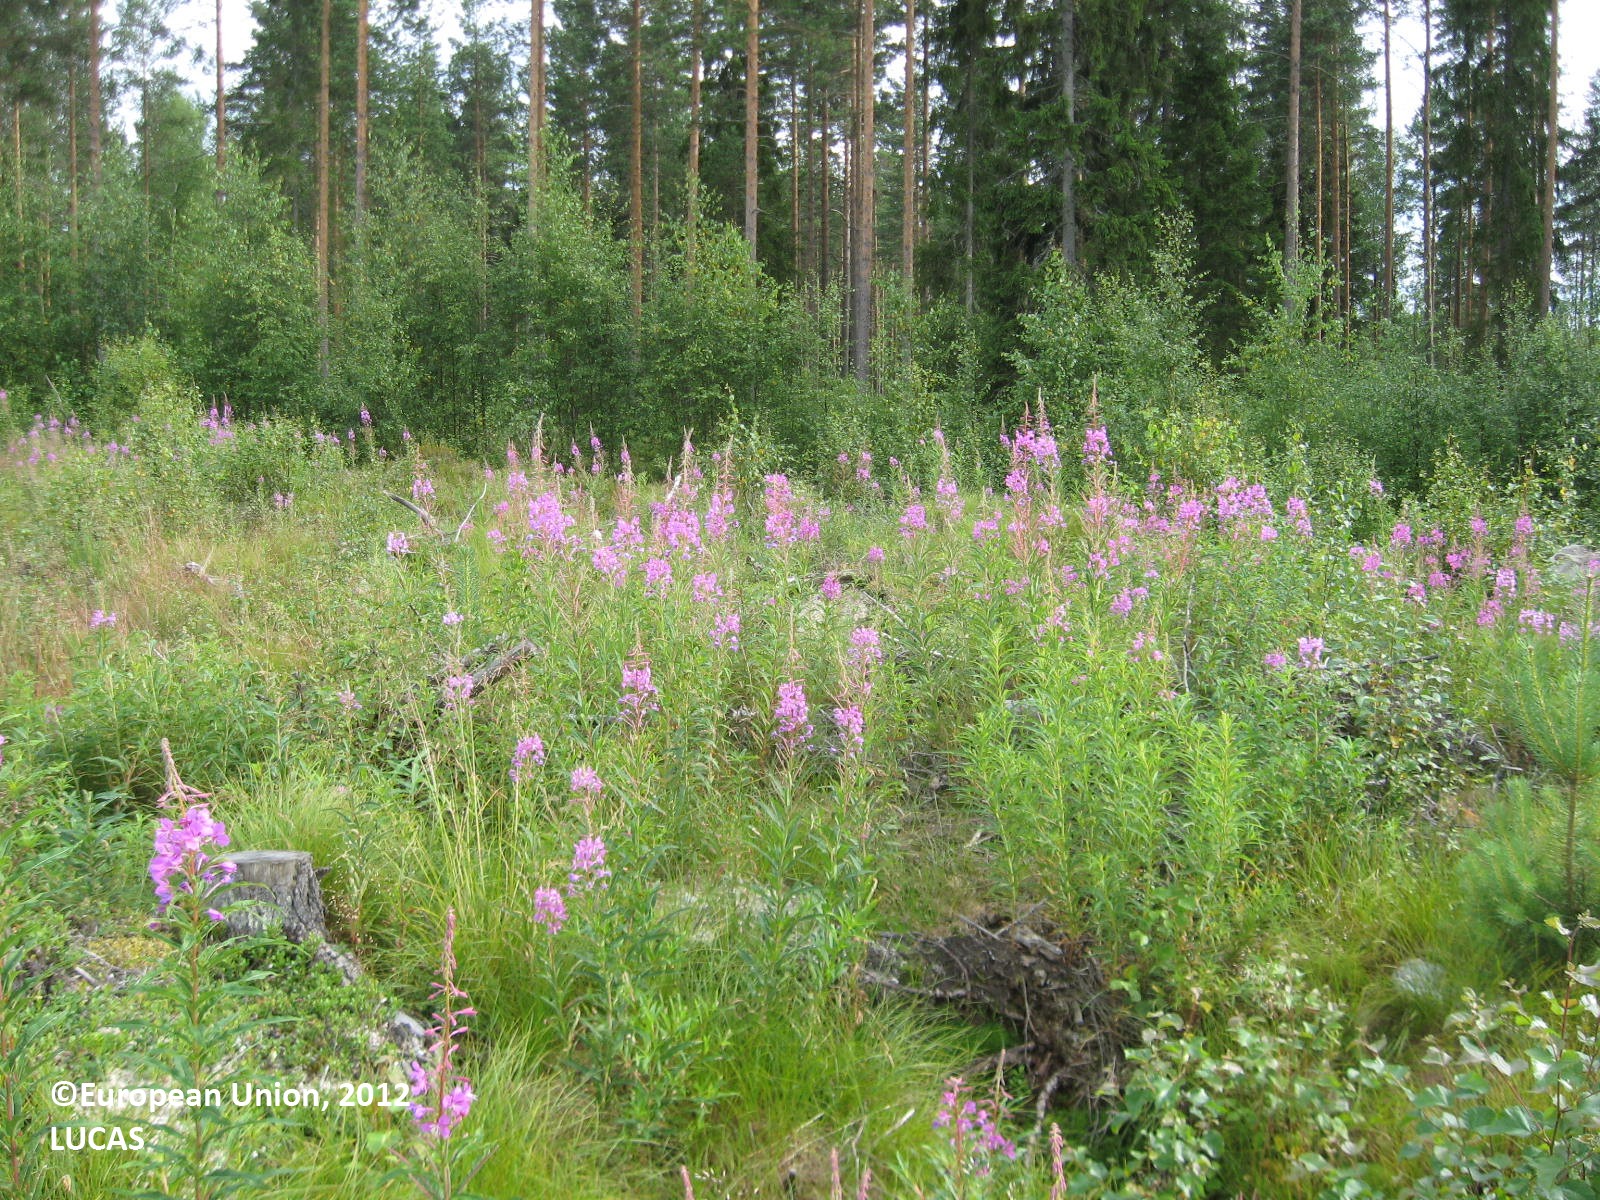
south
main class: Grassland
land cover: Grassland with sparse tree/shrub cover
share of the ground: 10 - 25 %
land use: Forestry
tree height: < 5 m
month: July
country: FI
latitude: 62.2121
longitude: 22.3422
